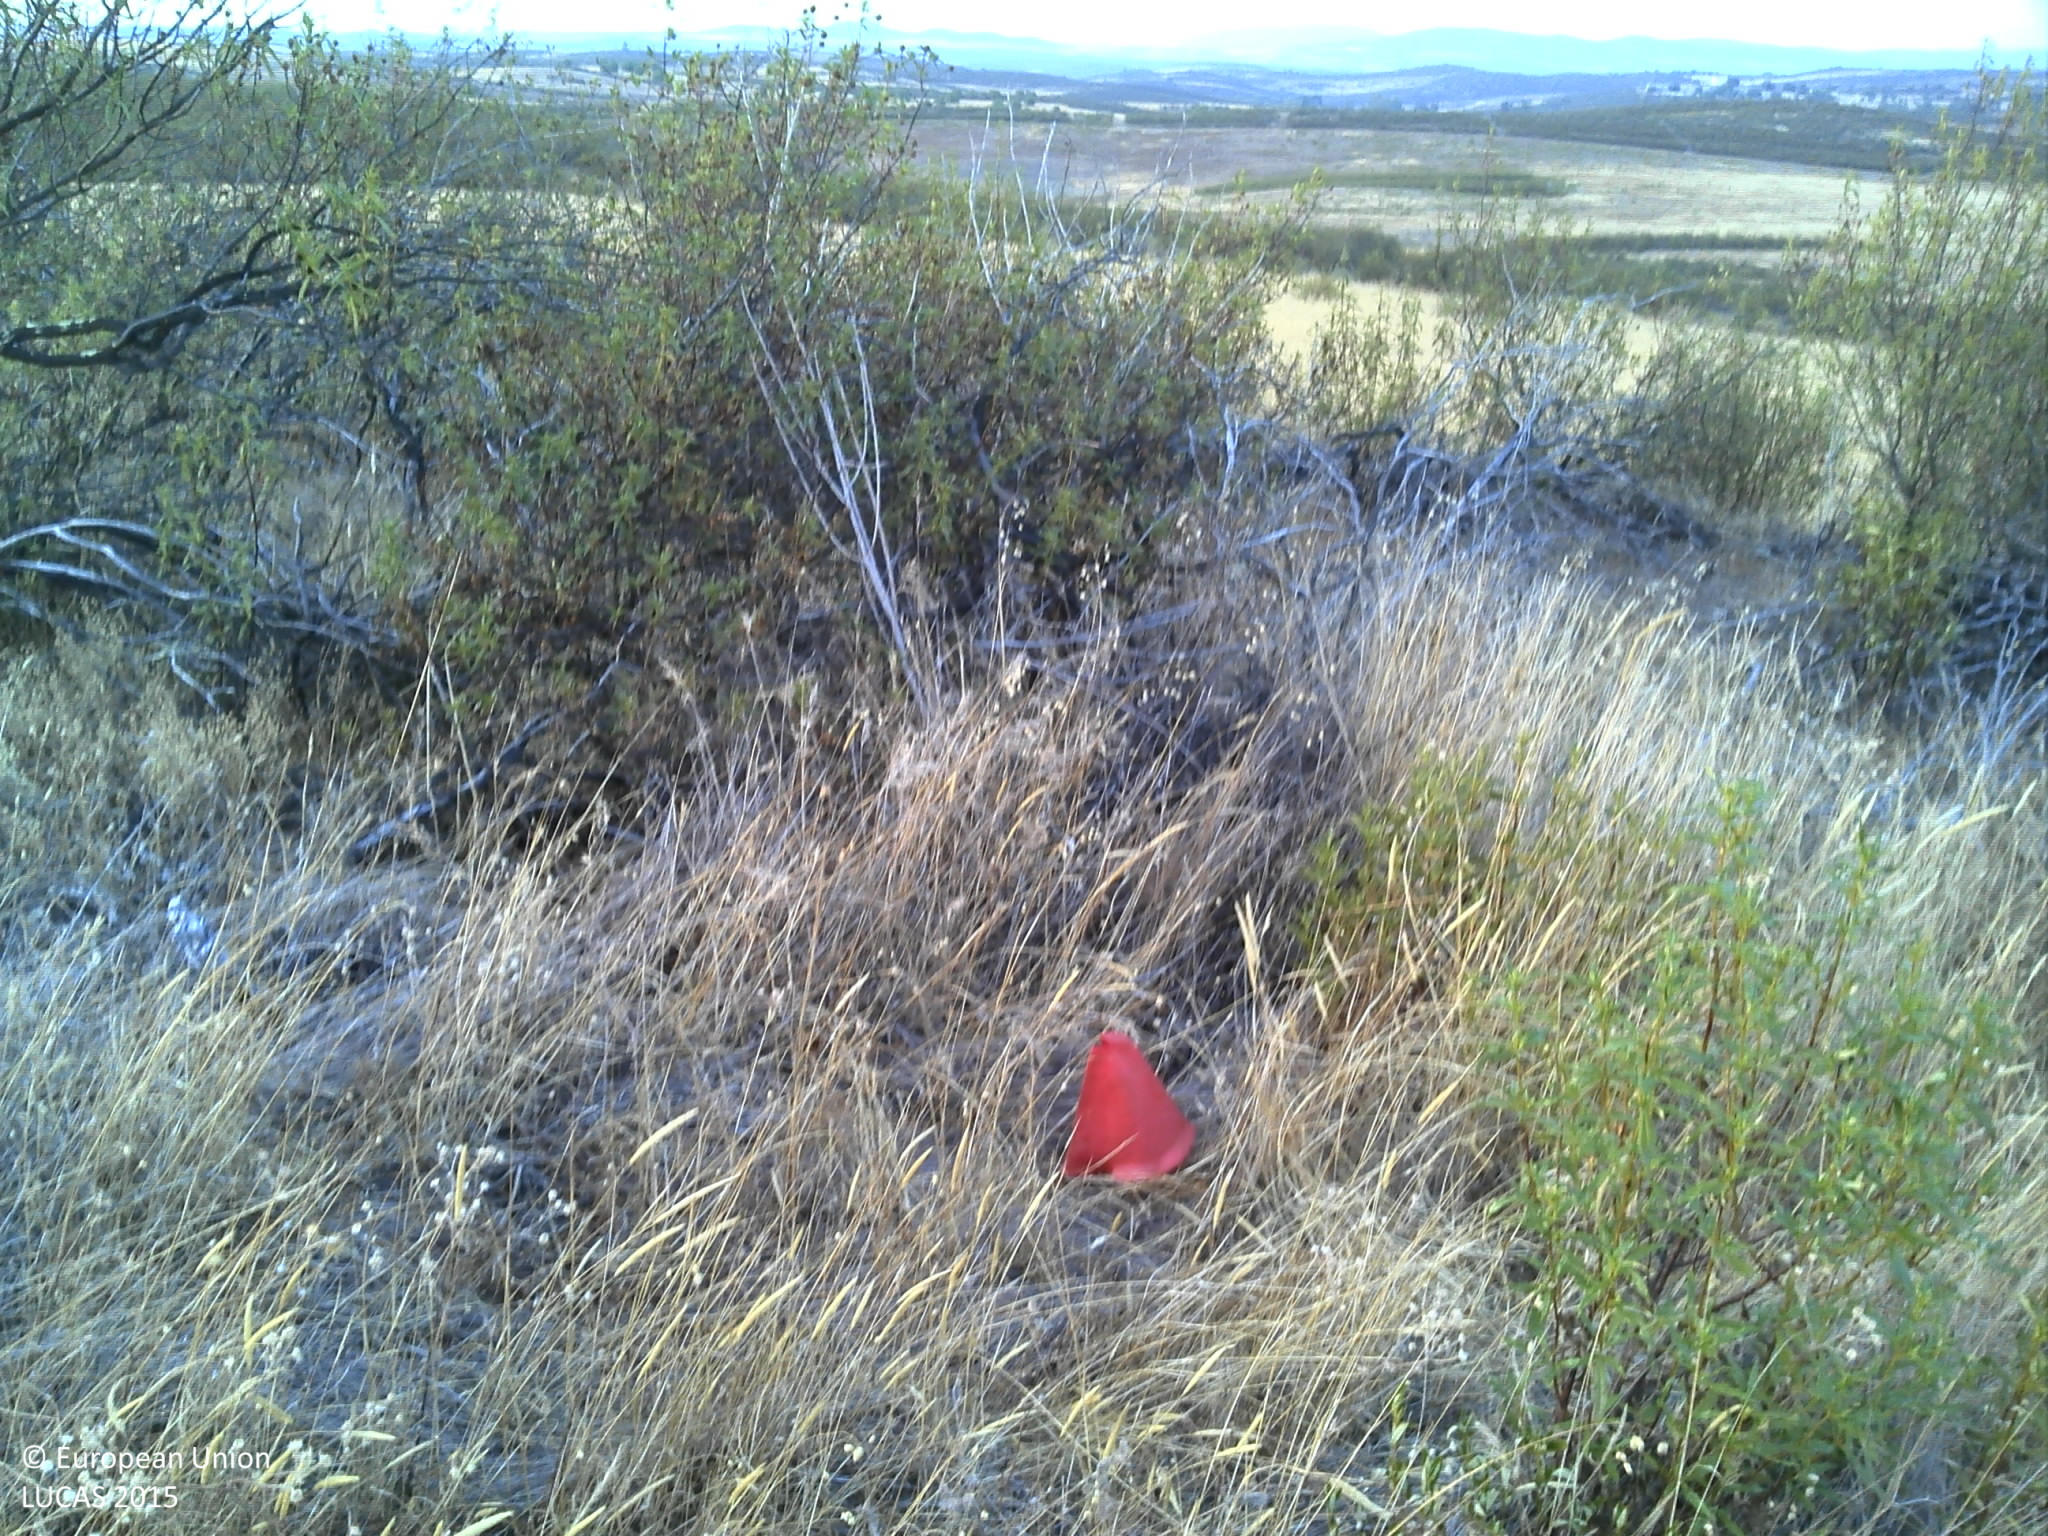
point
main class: Shrubland
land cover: Shrubland without tree cover
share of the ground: 50 - 75 %
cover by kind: shrubs 70 %, herbaceous plants 20 %, unconsolidated bare surface 10 %
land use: Abandoned areas
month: July
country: PT
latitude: 37.5751
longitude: -7.8753
